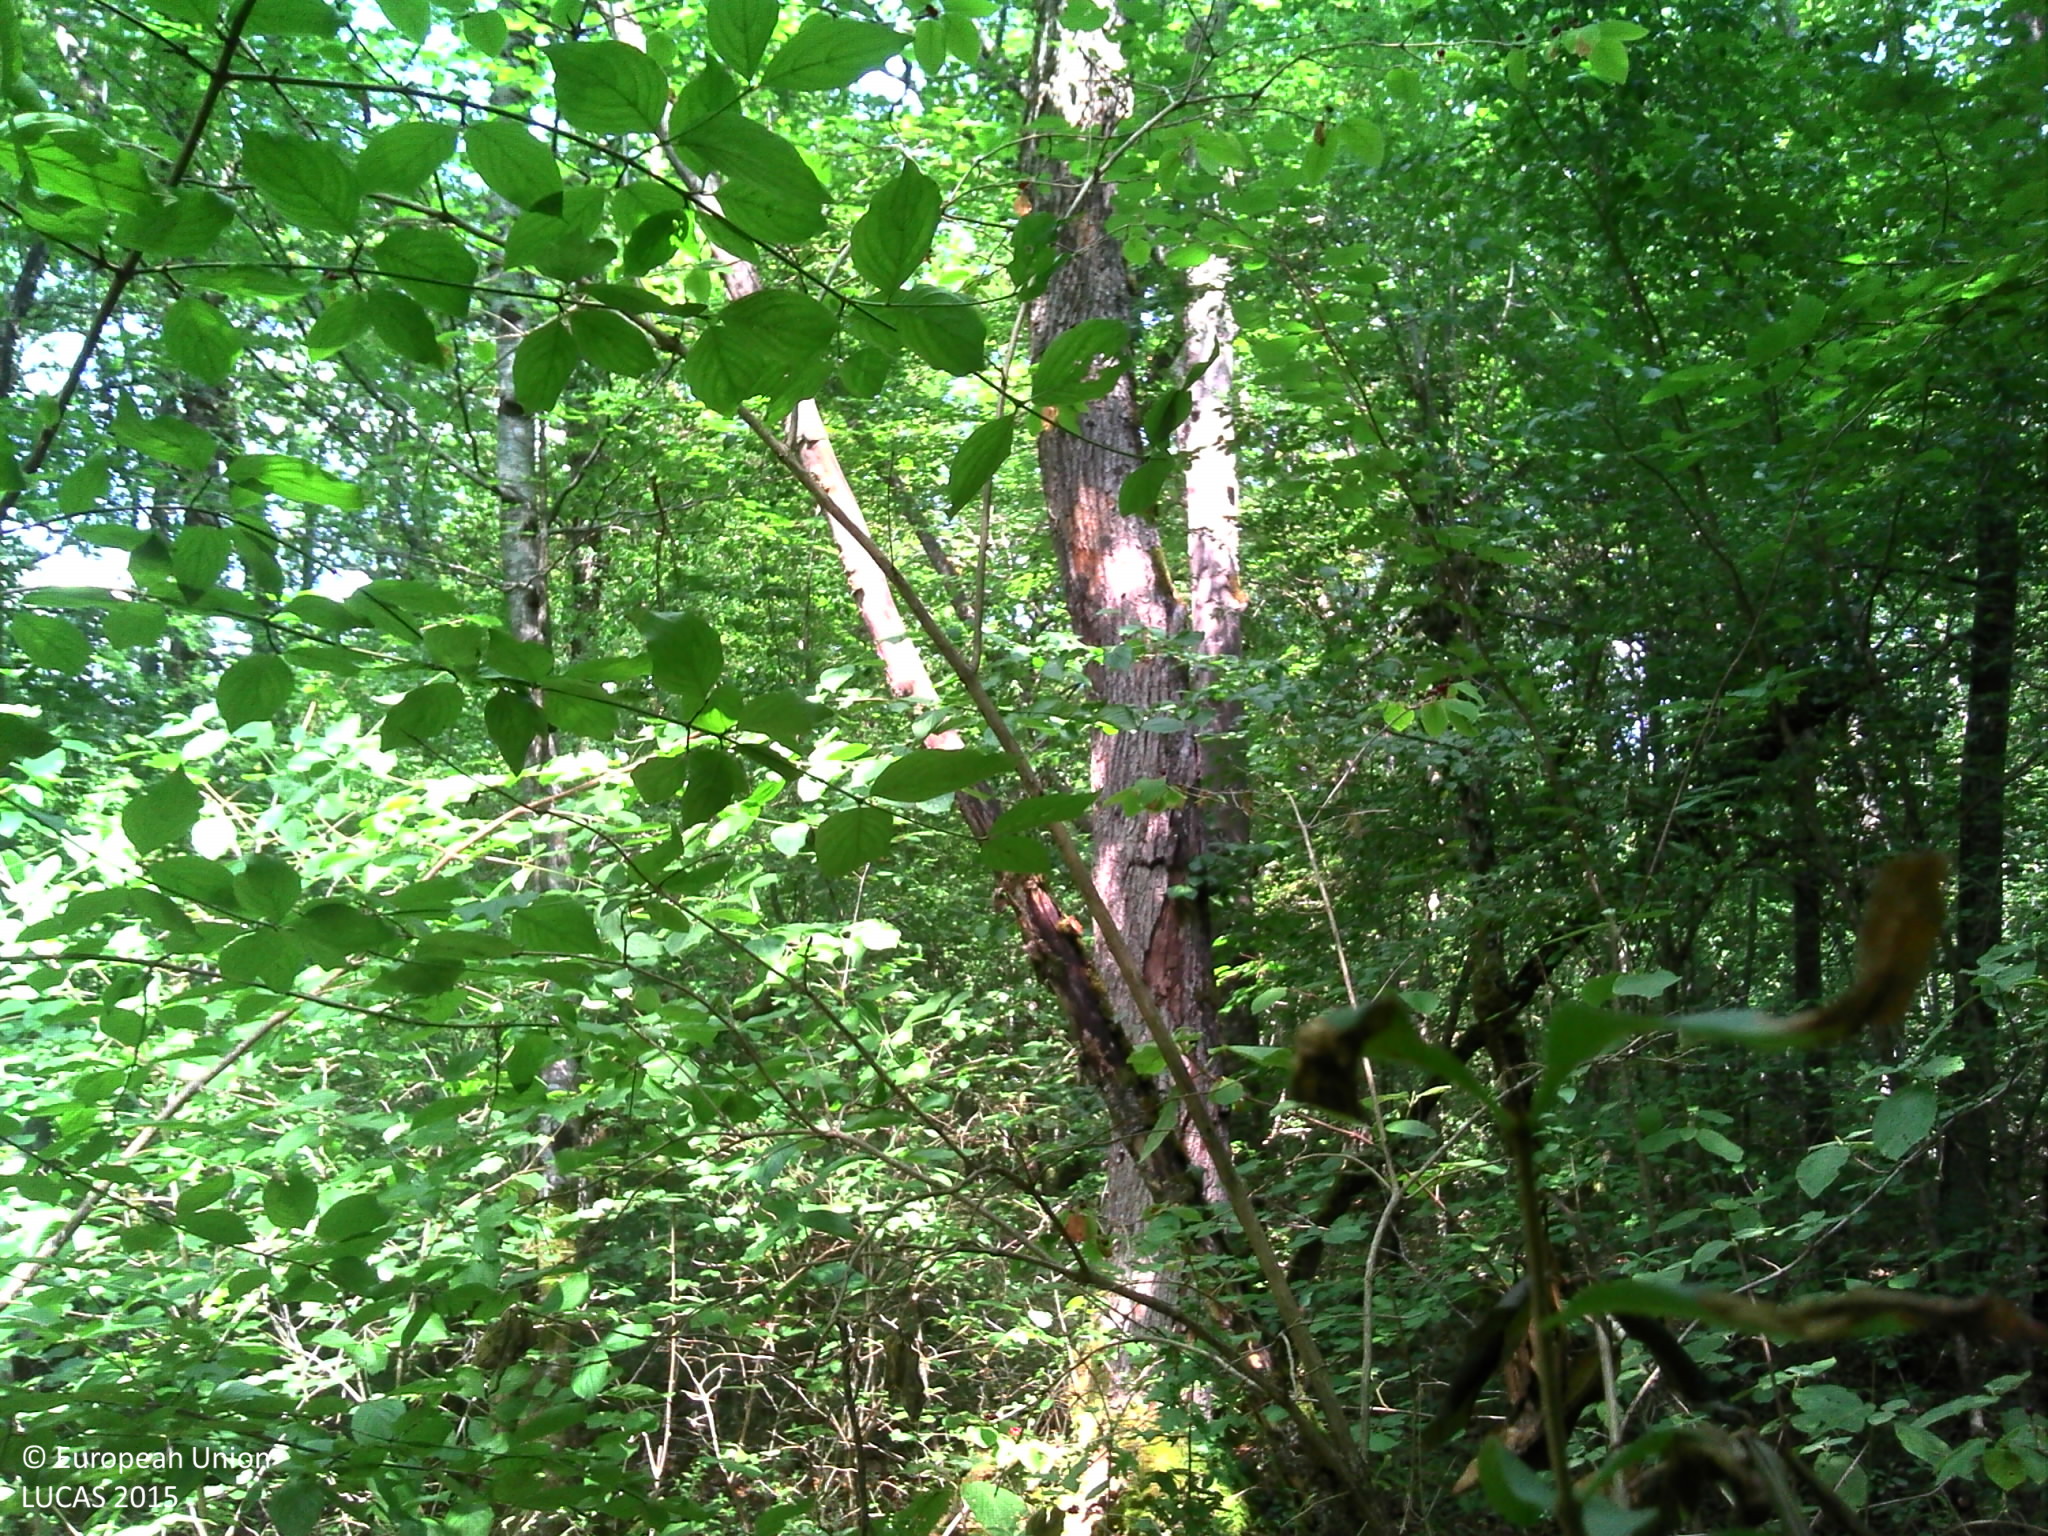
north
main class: Woodland
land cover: Broadleaved woodland
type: mesophytic deciduous forest
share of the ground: > 75 %
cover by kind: broadleaved forest trees 80 %, herbaceous plants 15 %, lichens and mosses 5 %
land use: Forestry
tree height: > 5 m
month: July
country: FR
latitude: 47.8584
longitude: 5.0139
